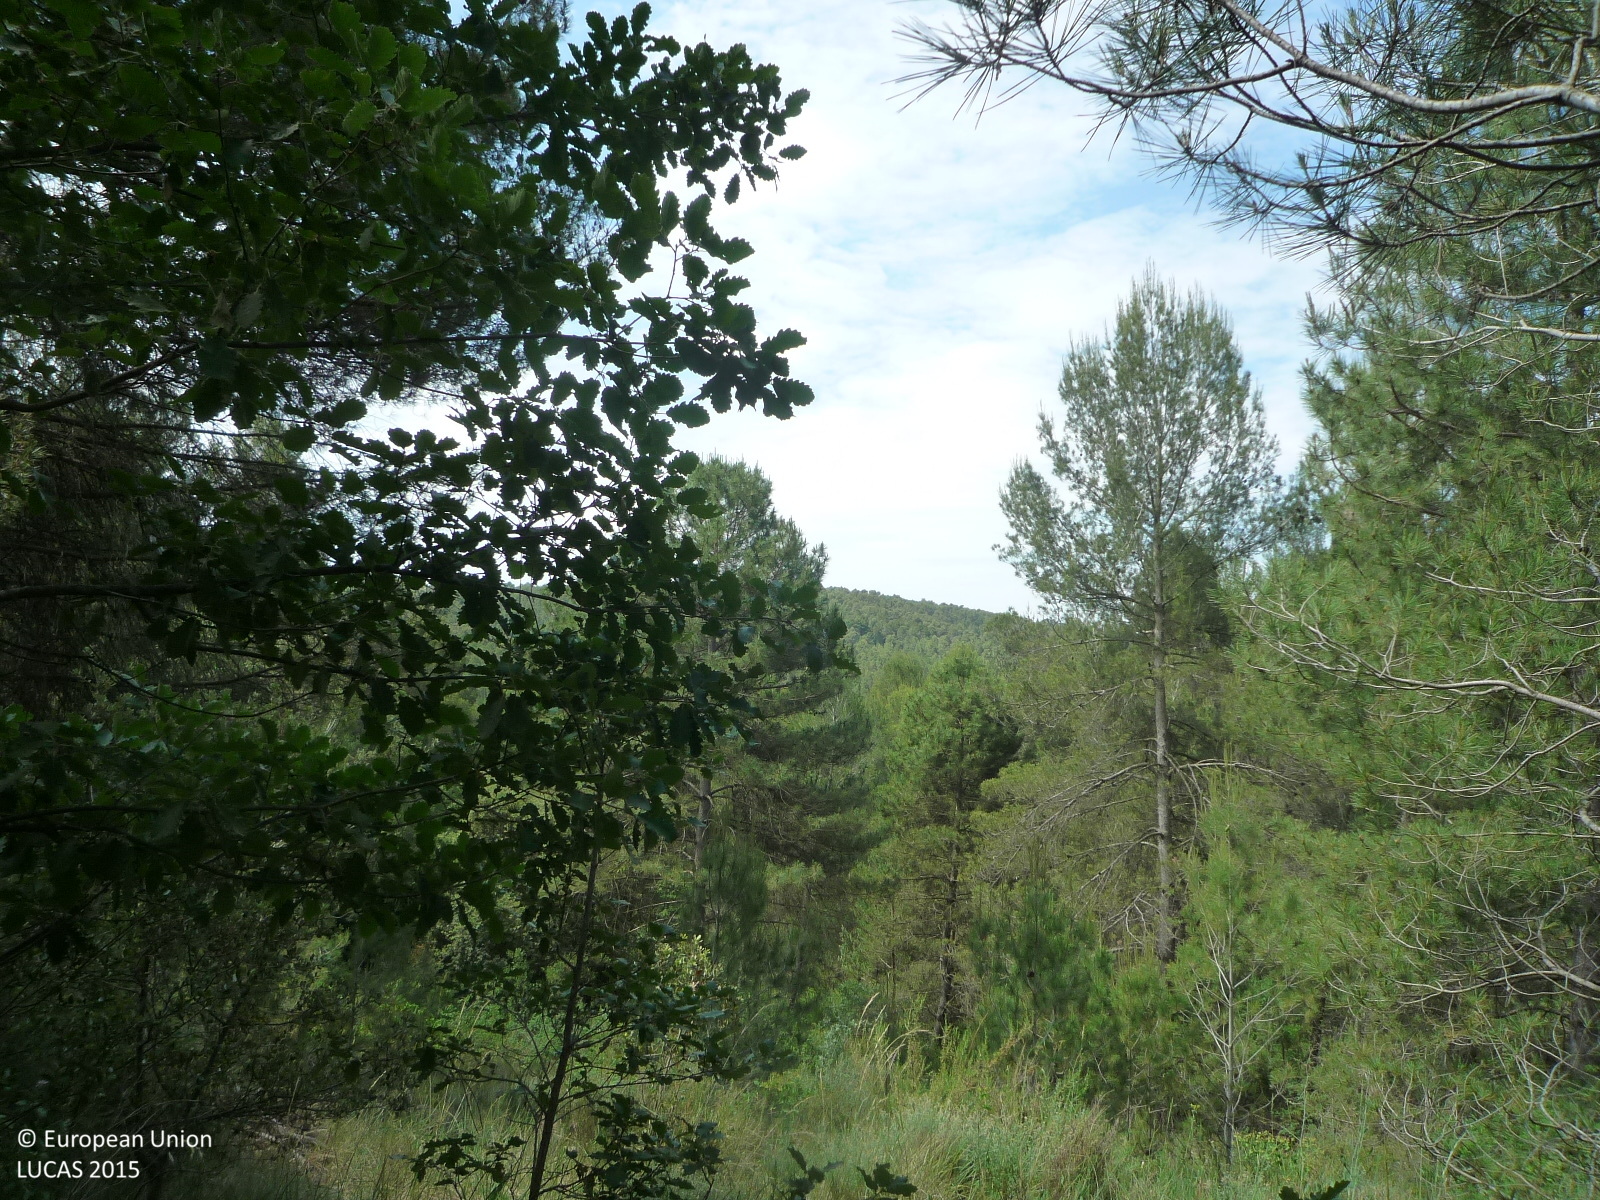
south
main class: Woodland
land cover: Pine dominated mixed woodland
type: coniferous forest of the mediterranean region
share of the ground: > 75 %
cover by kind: coniferous forest trees 60 %, broadleaved forest trees 40 %
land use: Semi-natural and natural areas not in use
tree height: > 5 m
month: June
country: ES
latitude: 41.8676
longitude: 2.0271
